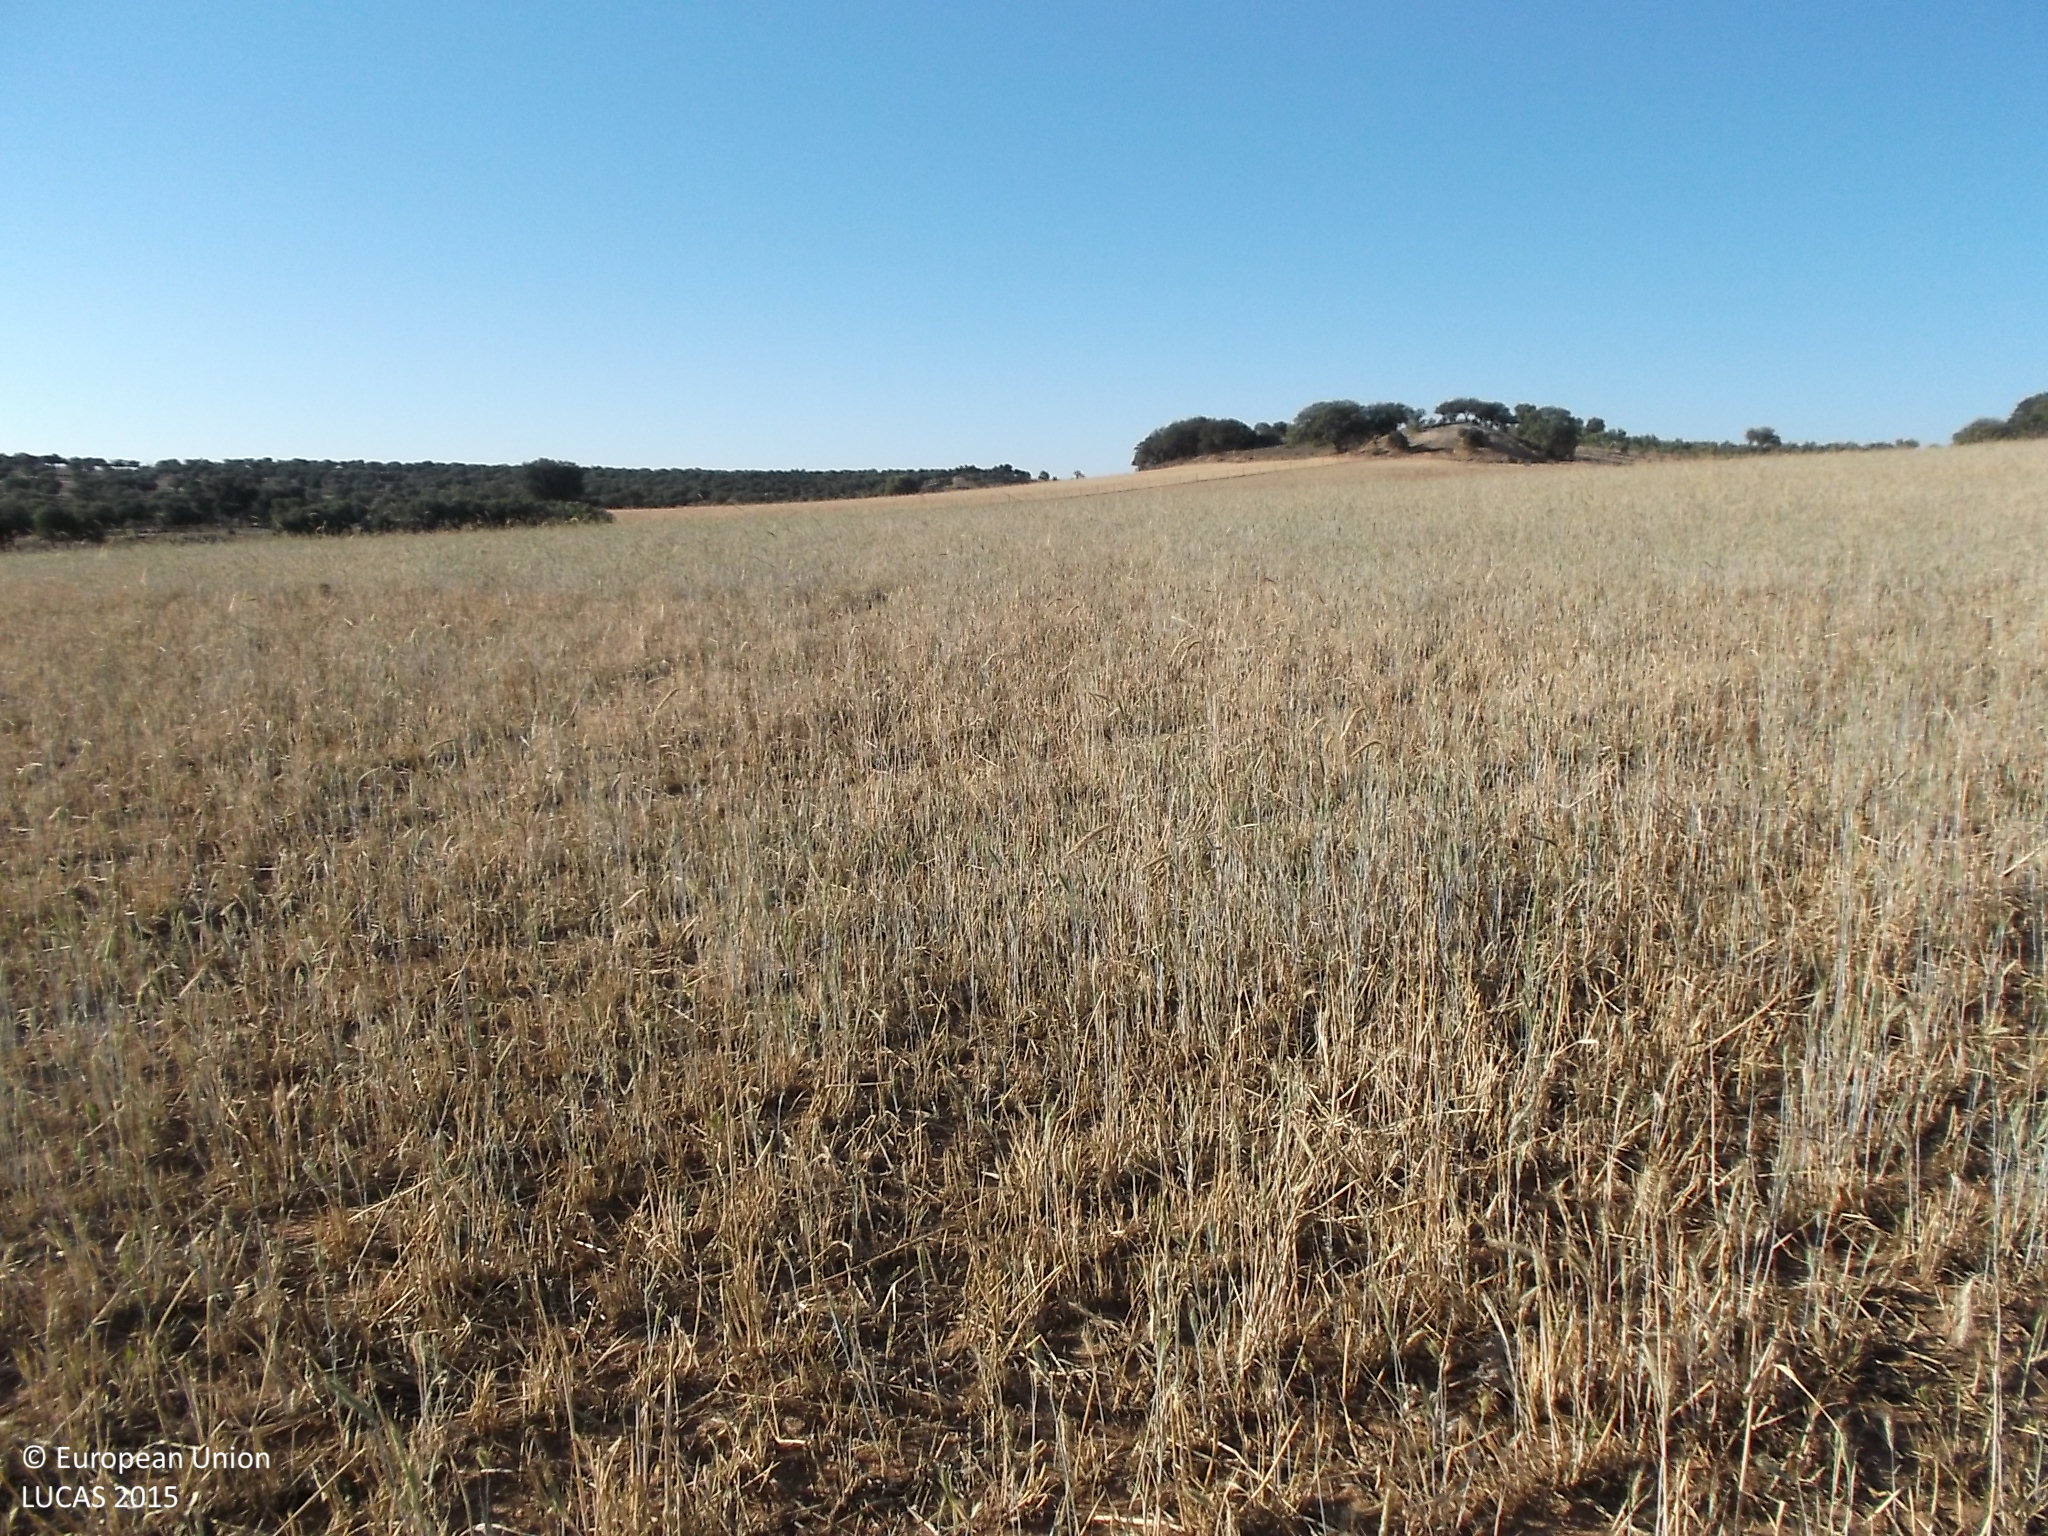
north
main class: Cropland
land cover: Rye
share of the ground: > 75 %
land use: Agriculture (excluding fallow land and kitchen gardens)
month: June
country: ES
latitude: 41.3102
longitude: -5.3533
